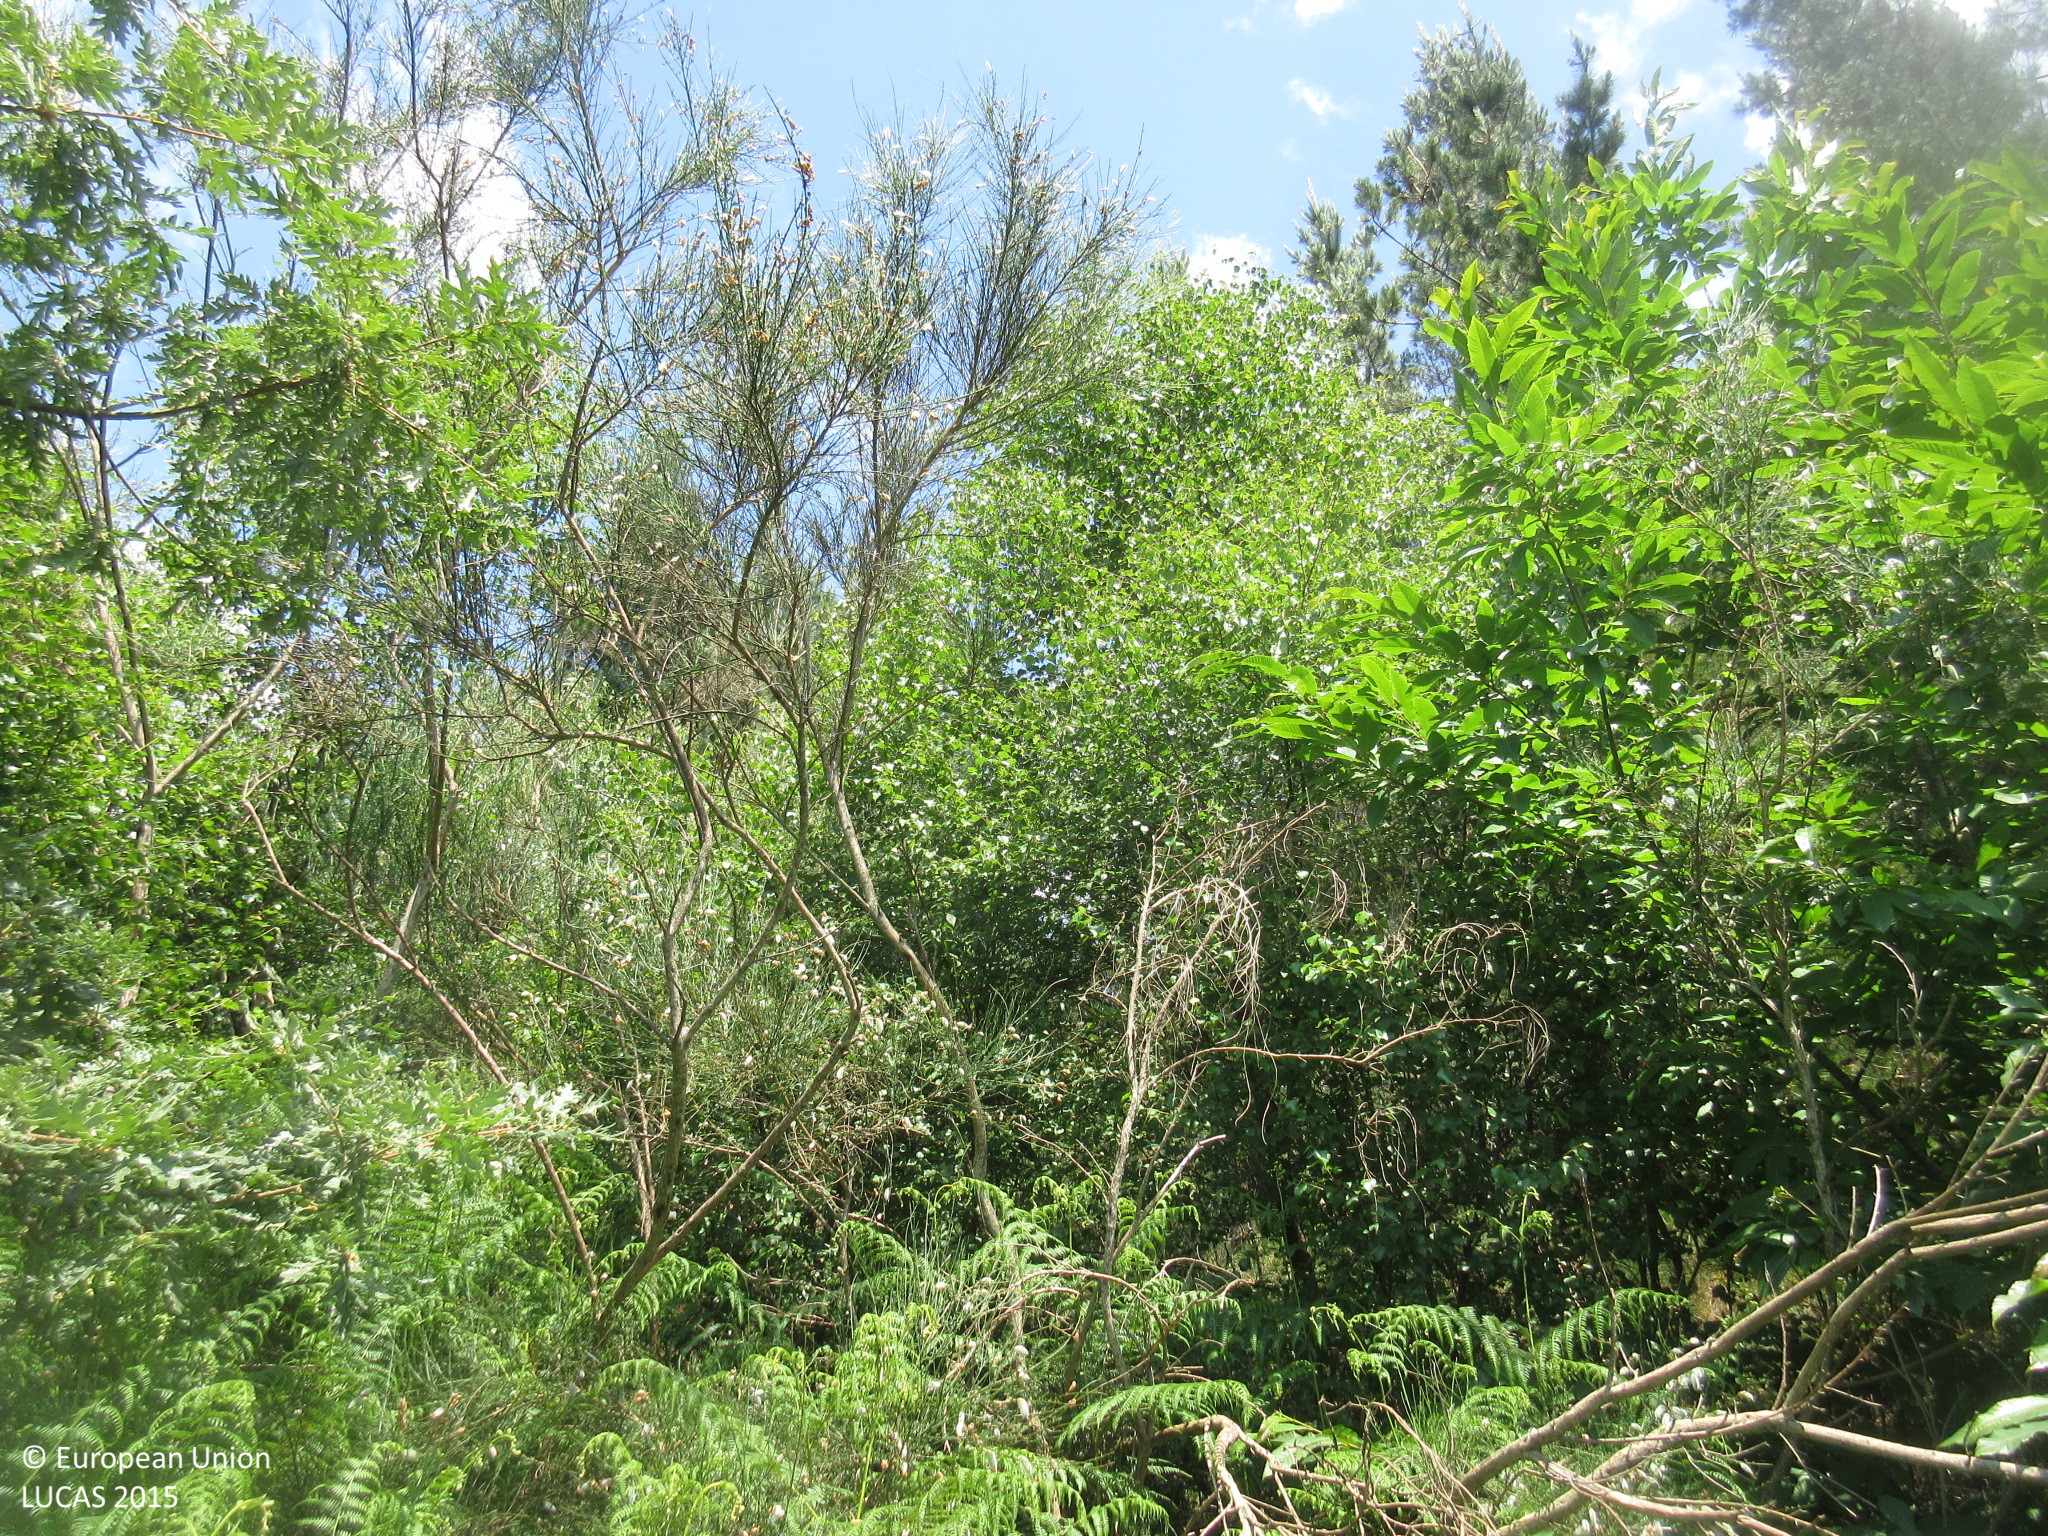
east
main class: Woodland
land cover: Other mixed woodland
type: acidophilous oak and oak-birch forest
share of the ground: > 75 %
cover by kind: broadleaved forest trees 60 %, coniferous forest trees 30 %, shrubs 10 %
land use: Forestry
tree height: > 5 m
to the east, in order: Other mixed woodland; Grass margins; Paved roads, cycling and walking lanes; Shruby margins; Pine dominated coniferous woodland; Shrubland without tree cover; Pine dominated mixed woodland; Shrubland without tree cover; Grass margins; Paved roads, cycling and walking lanes; Grass margins; Shrubland without tree cover
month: June
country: ES
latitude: 43.0174
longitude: -7.0580
